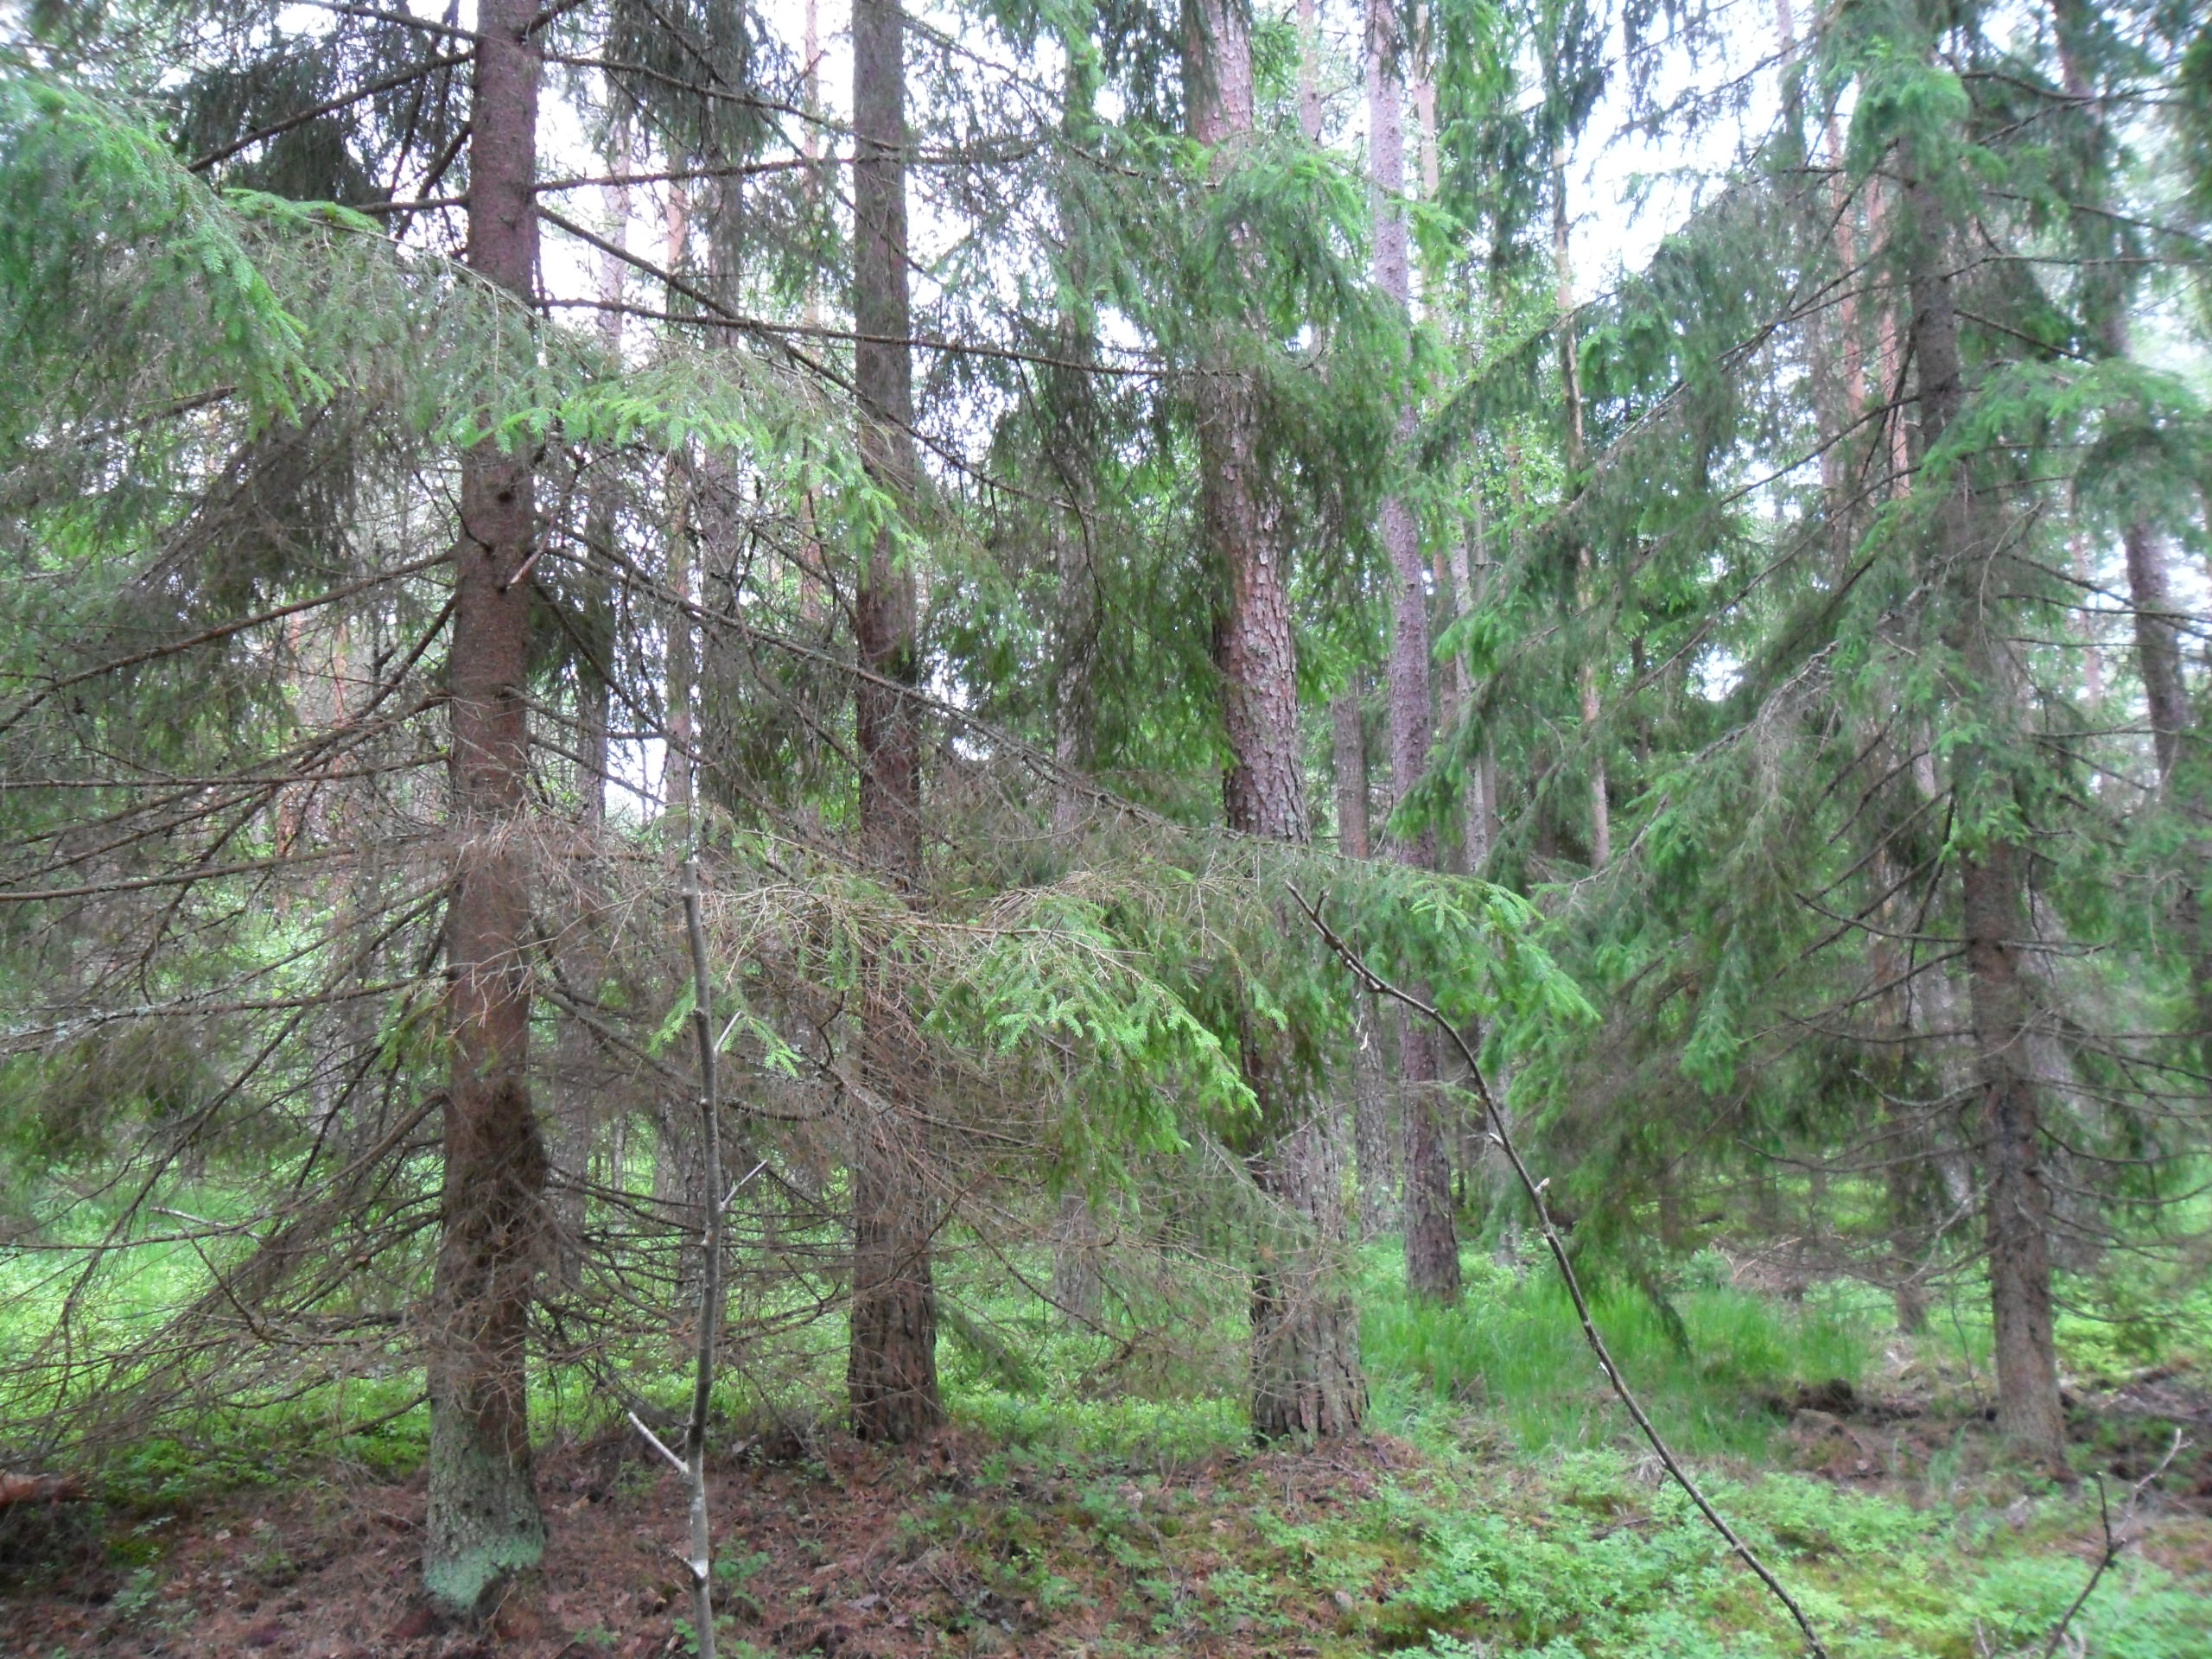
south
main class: Woodland
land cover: Other coniferous woodland
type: hemiboreal forest and nemoral coniferous forest and mixed broadleaved-coniferous forest
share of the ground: > 75 %
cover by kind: coniferous forest trees 70 %, broadleaved forest trees 15 %, herbaceous plants 15 %
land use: Forestry
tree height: > 5 m
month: June
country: LV
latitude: 57.2223
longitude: 22.0207
